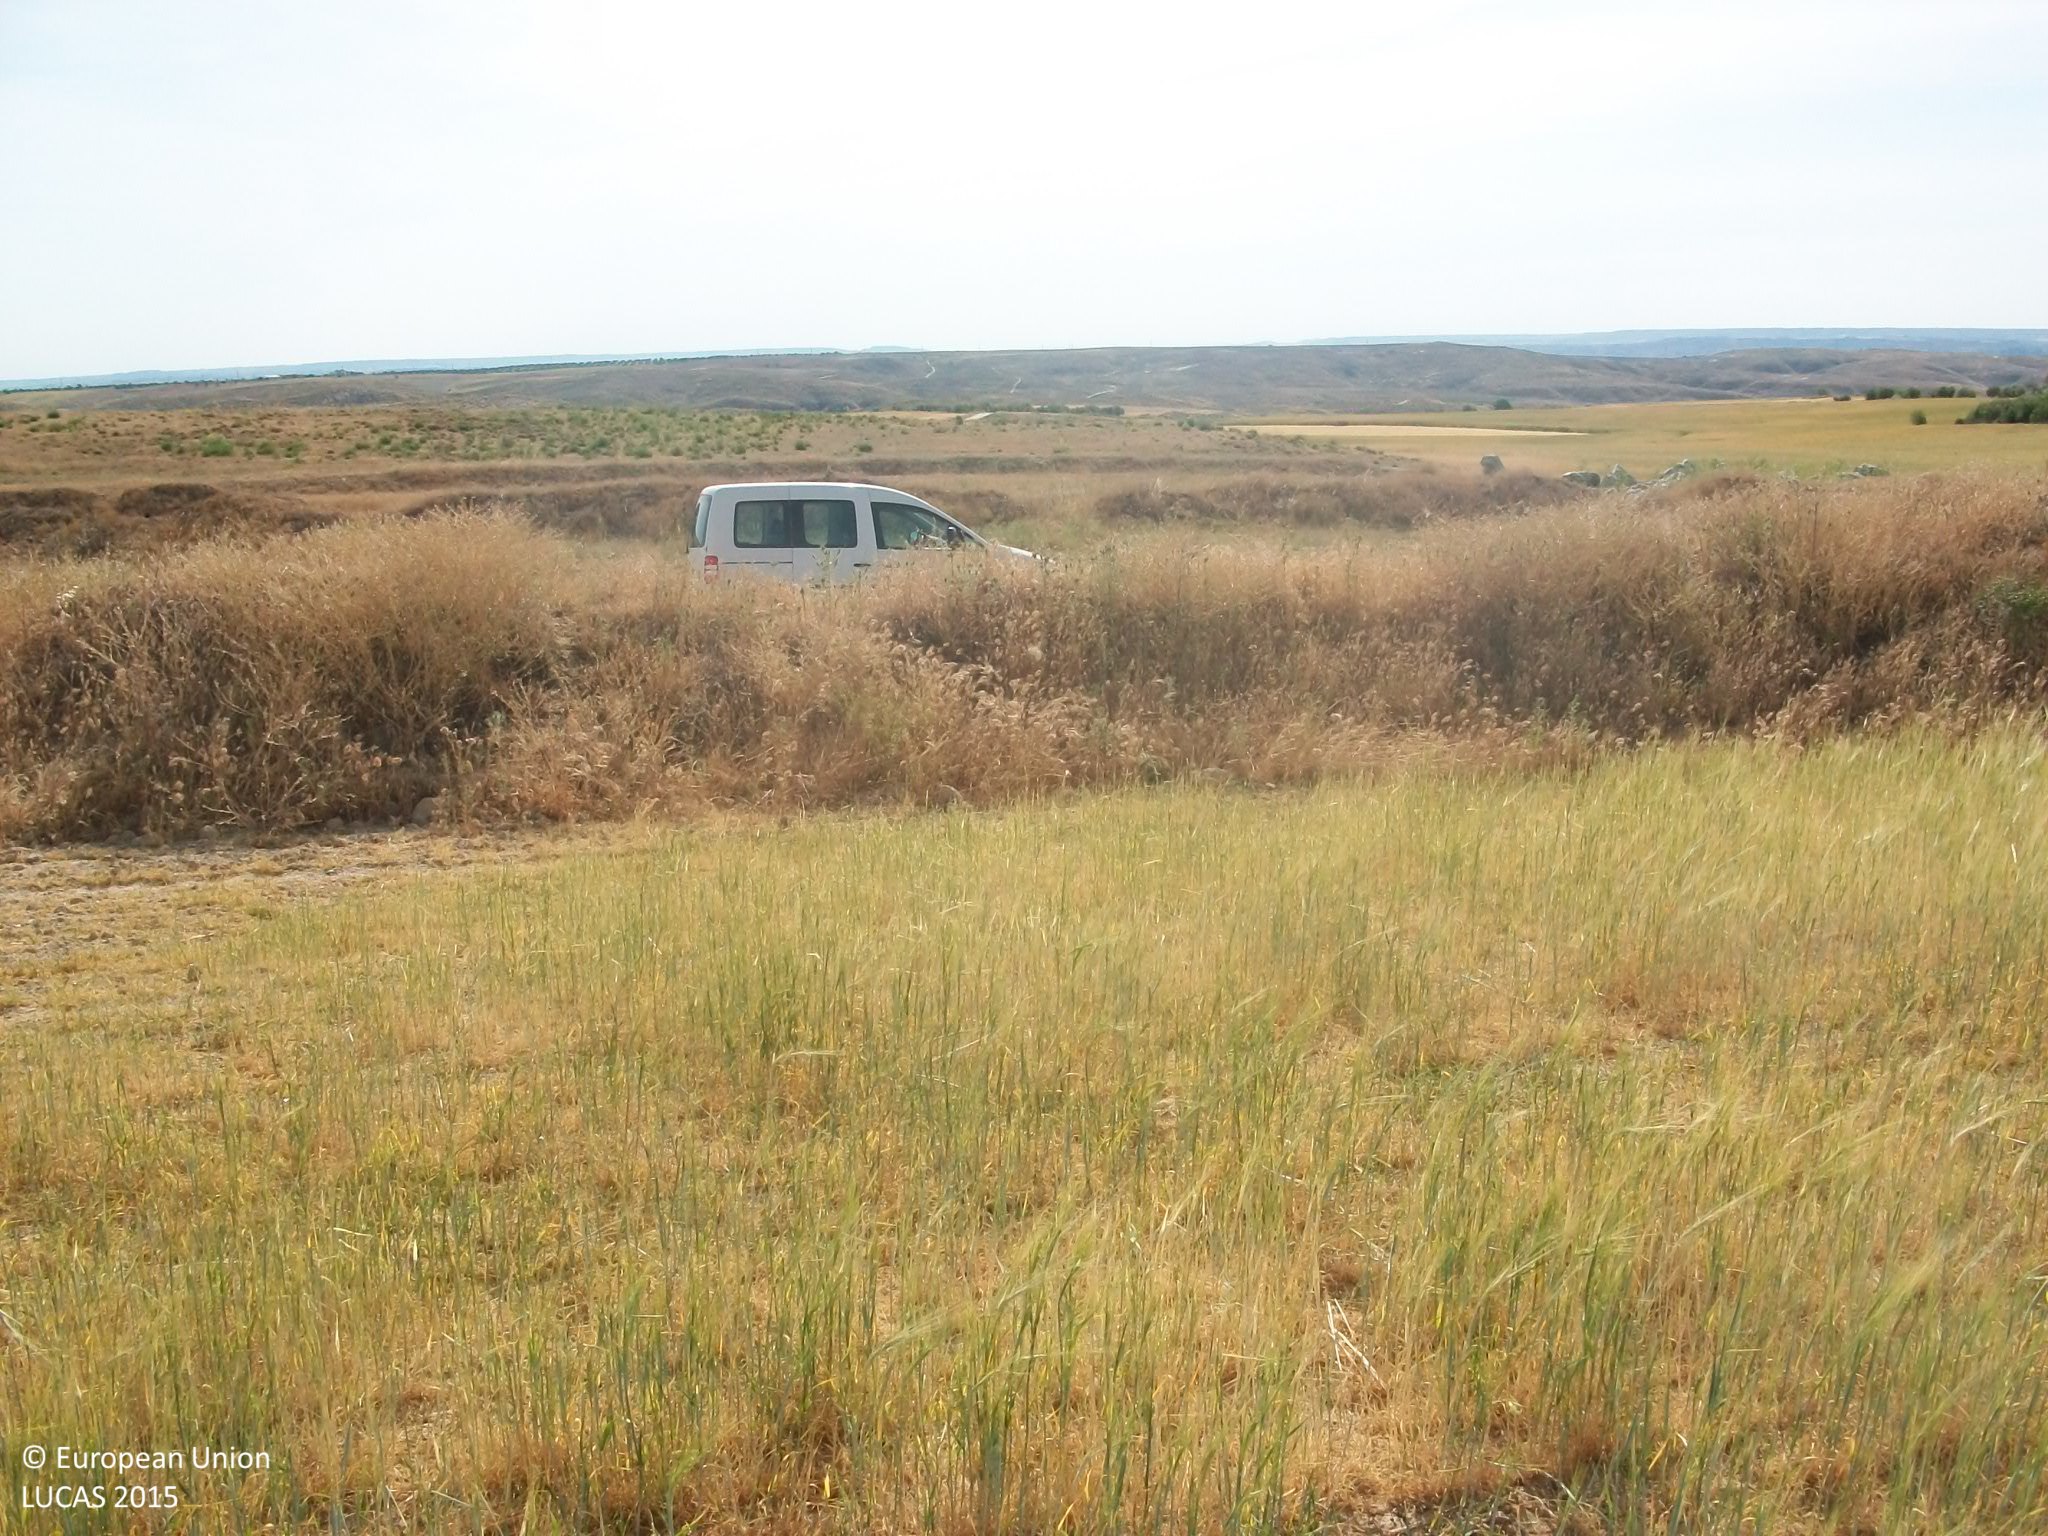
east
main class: Cropland
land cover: Barley
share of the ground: 50 - 75 %
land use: Agriculture (excluding fallow land and kitchen gardens)
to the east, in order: Barley; Grassland without tree/shrub cover; Tracks; Grassland without tree/shrub cover; Tracks; Grassland without tree/shrub cover; Tracks; Shrubland without tree cover; Tracks; Grass margins; Barley
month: May
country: ES
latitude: 40.0685
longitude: -3.7162
